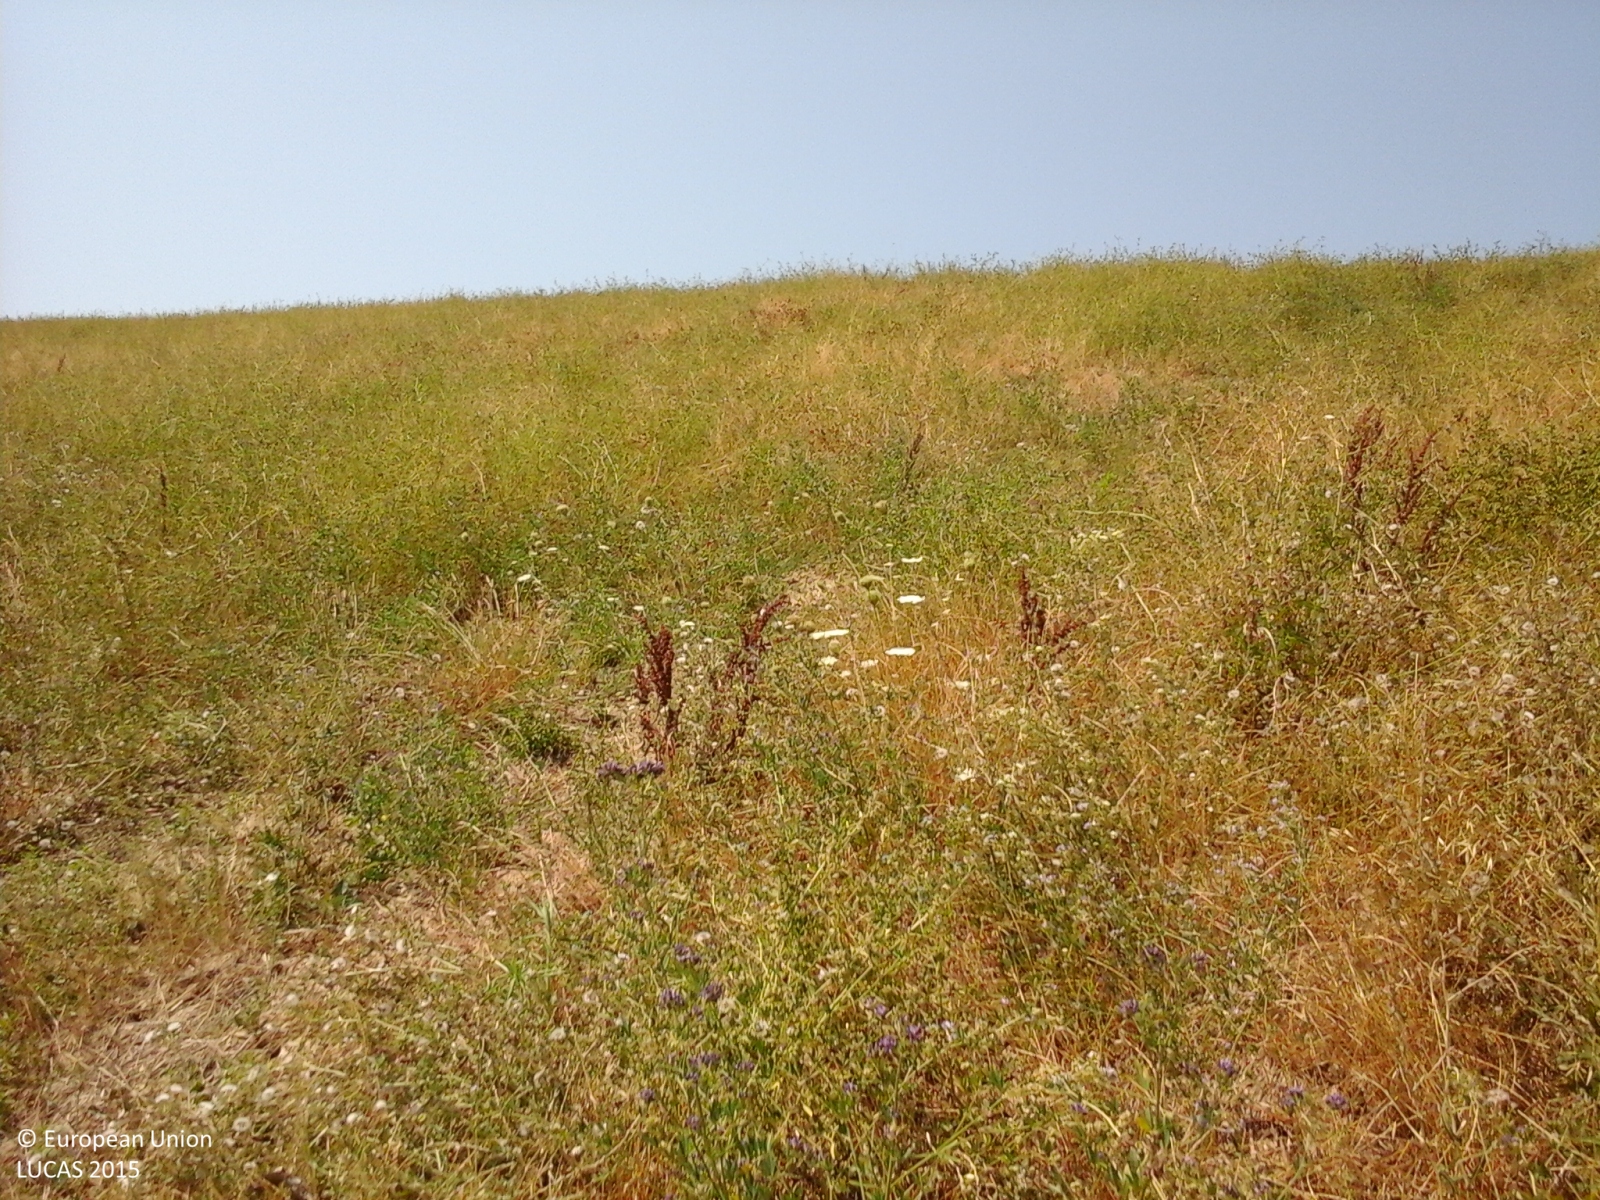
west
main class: Grassland
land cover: Spontaneously vegetated surfaces
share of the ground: > 75 %
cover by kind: herbaceous plants 100 %
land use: Fallow land
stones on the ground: < 10 %
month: August
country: IT
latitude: 43.7461
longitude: 12.3659
